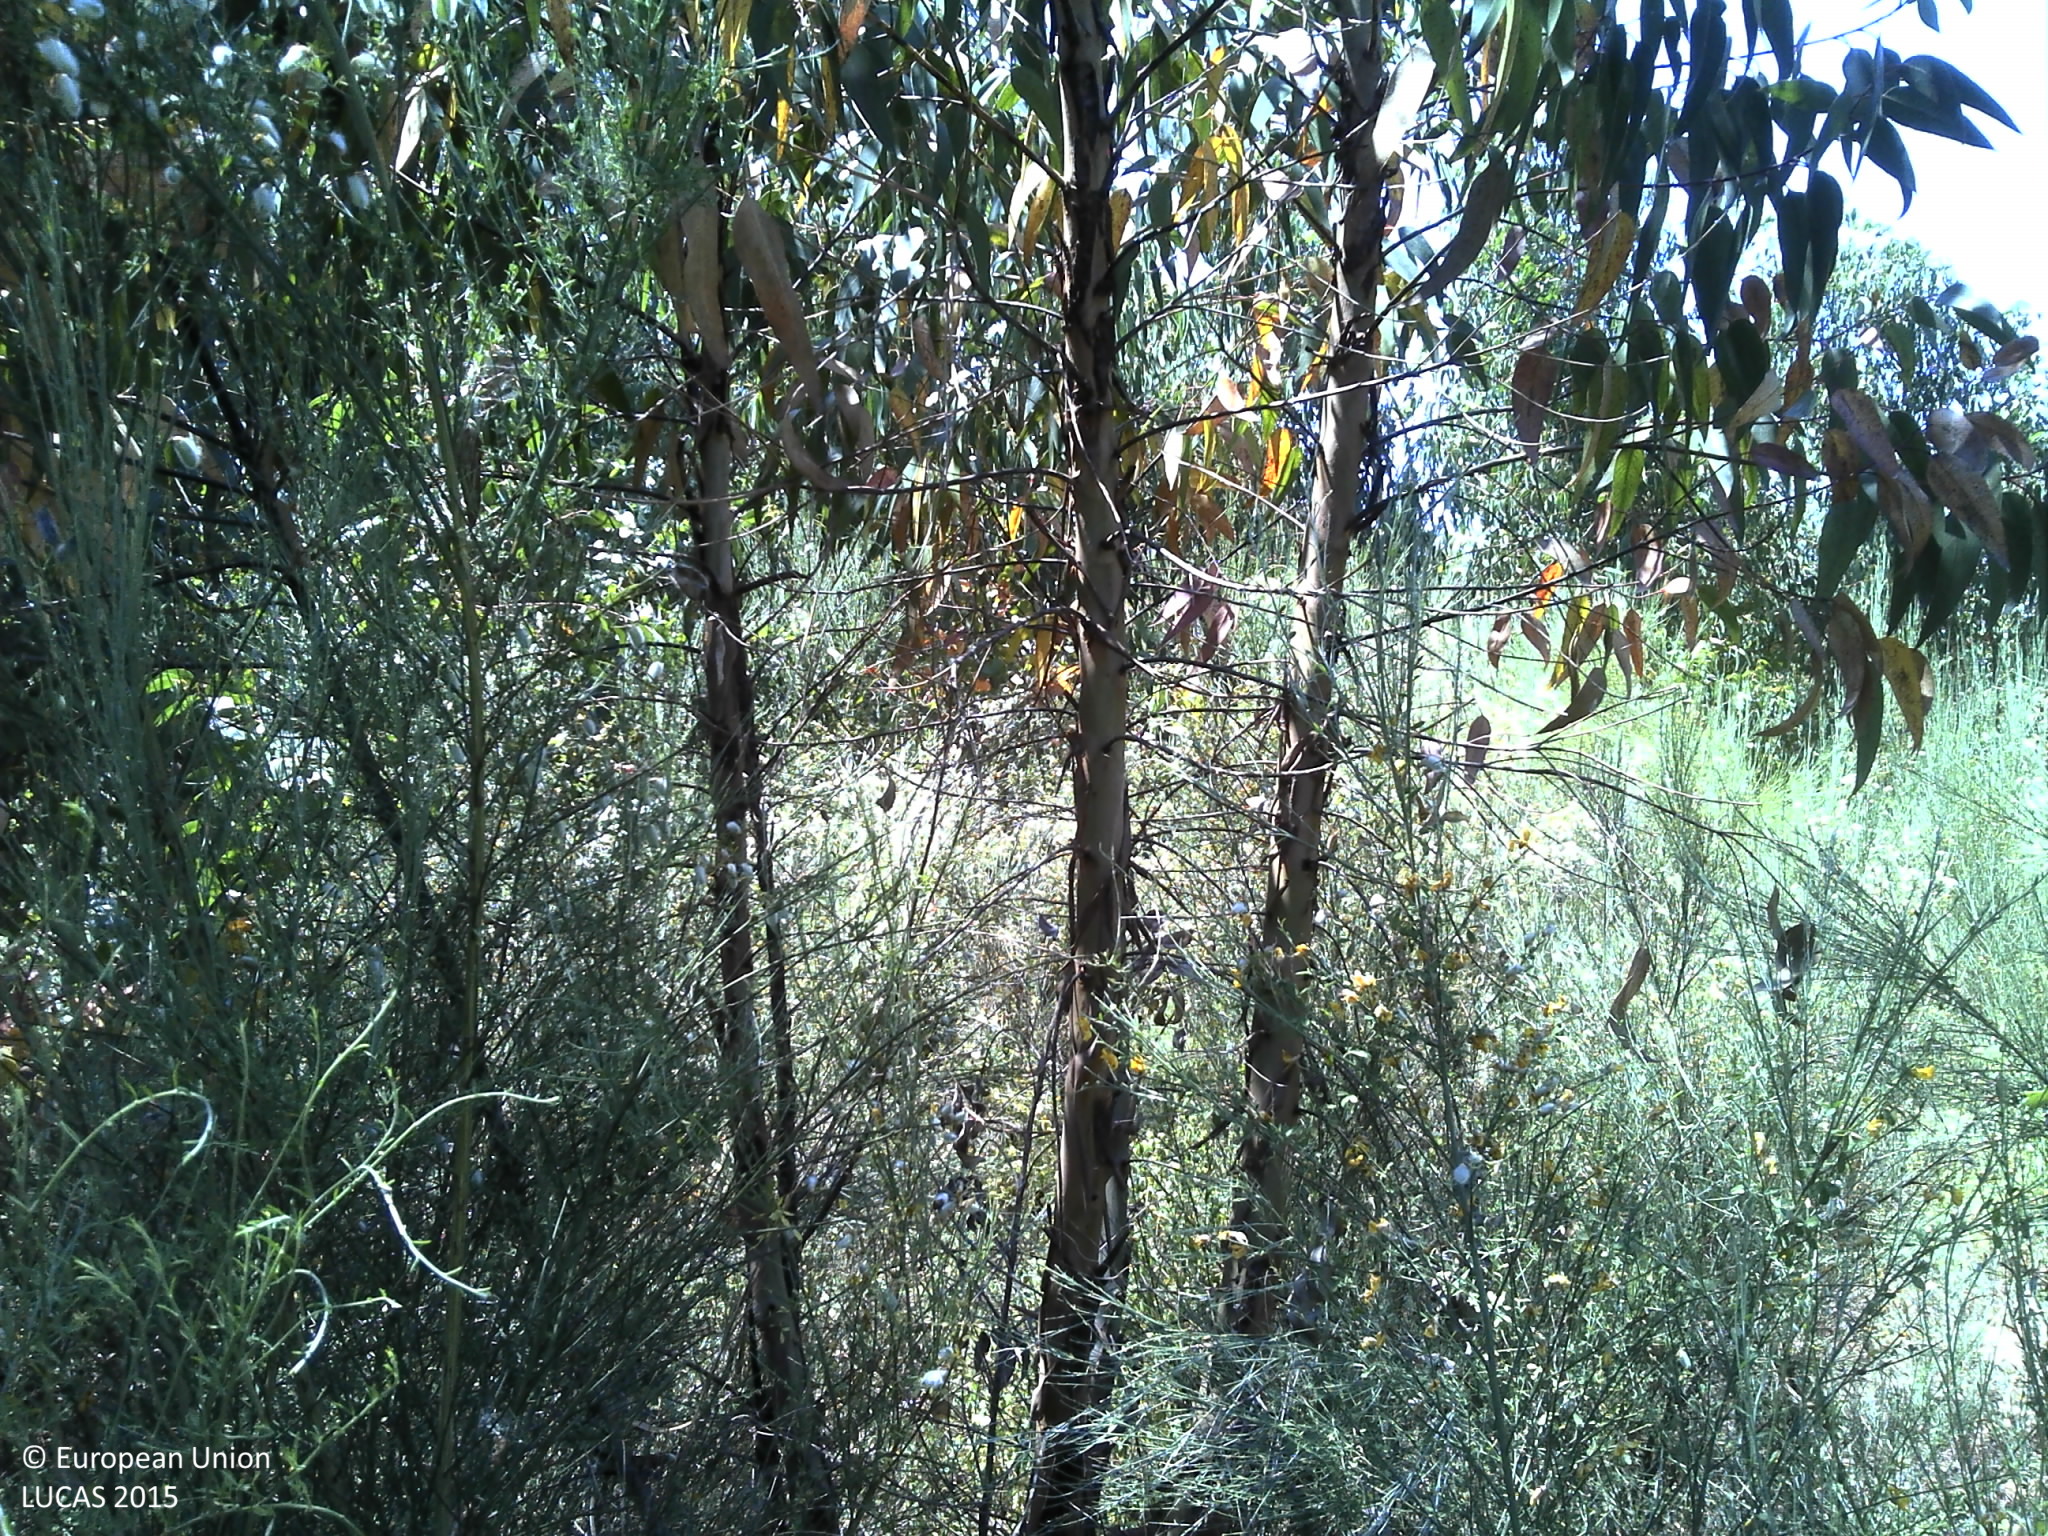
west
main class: Woodland
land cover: Broadleaved woodland
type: exotic forest
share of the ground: 50 - 75 %
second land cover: Shrubland without tree cover
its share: > 75 %
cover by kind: broadleaved forest trees 75 %, shrubs 25 %
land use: Forestry
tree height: > 5 m
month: May
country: PT
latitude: 39.4688
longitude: -7.7316
